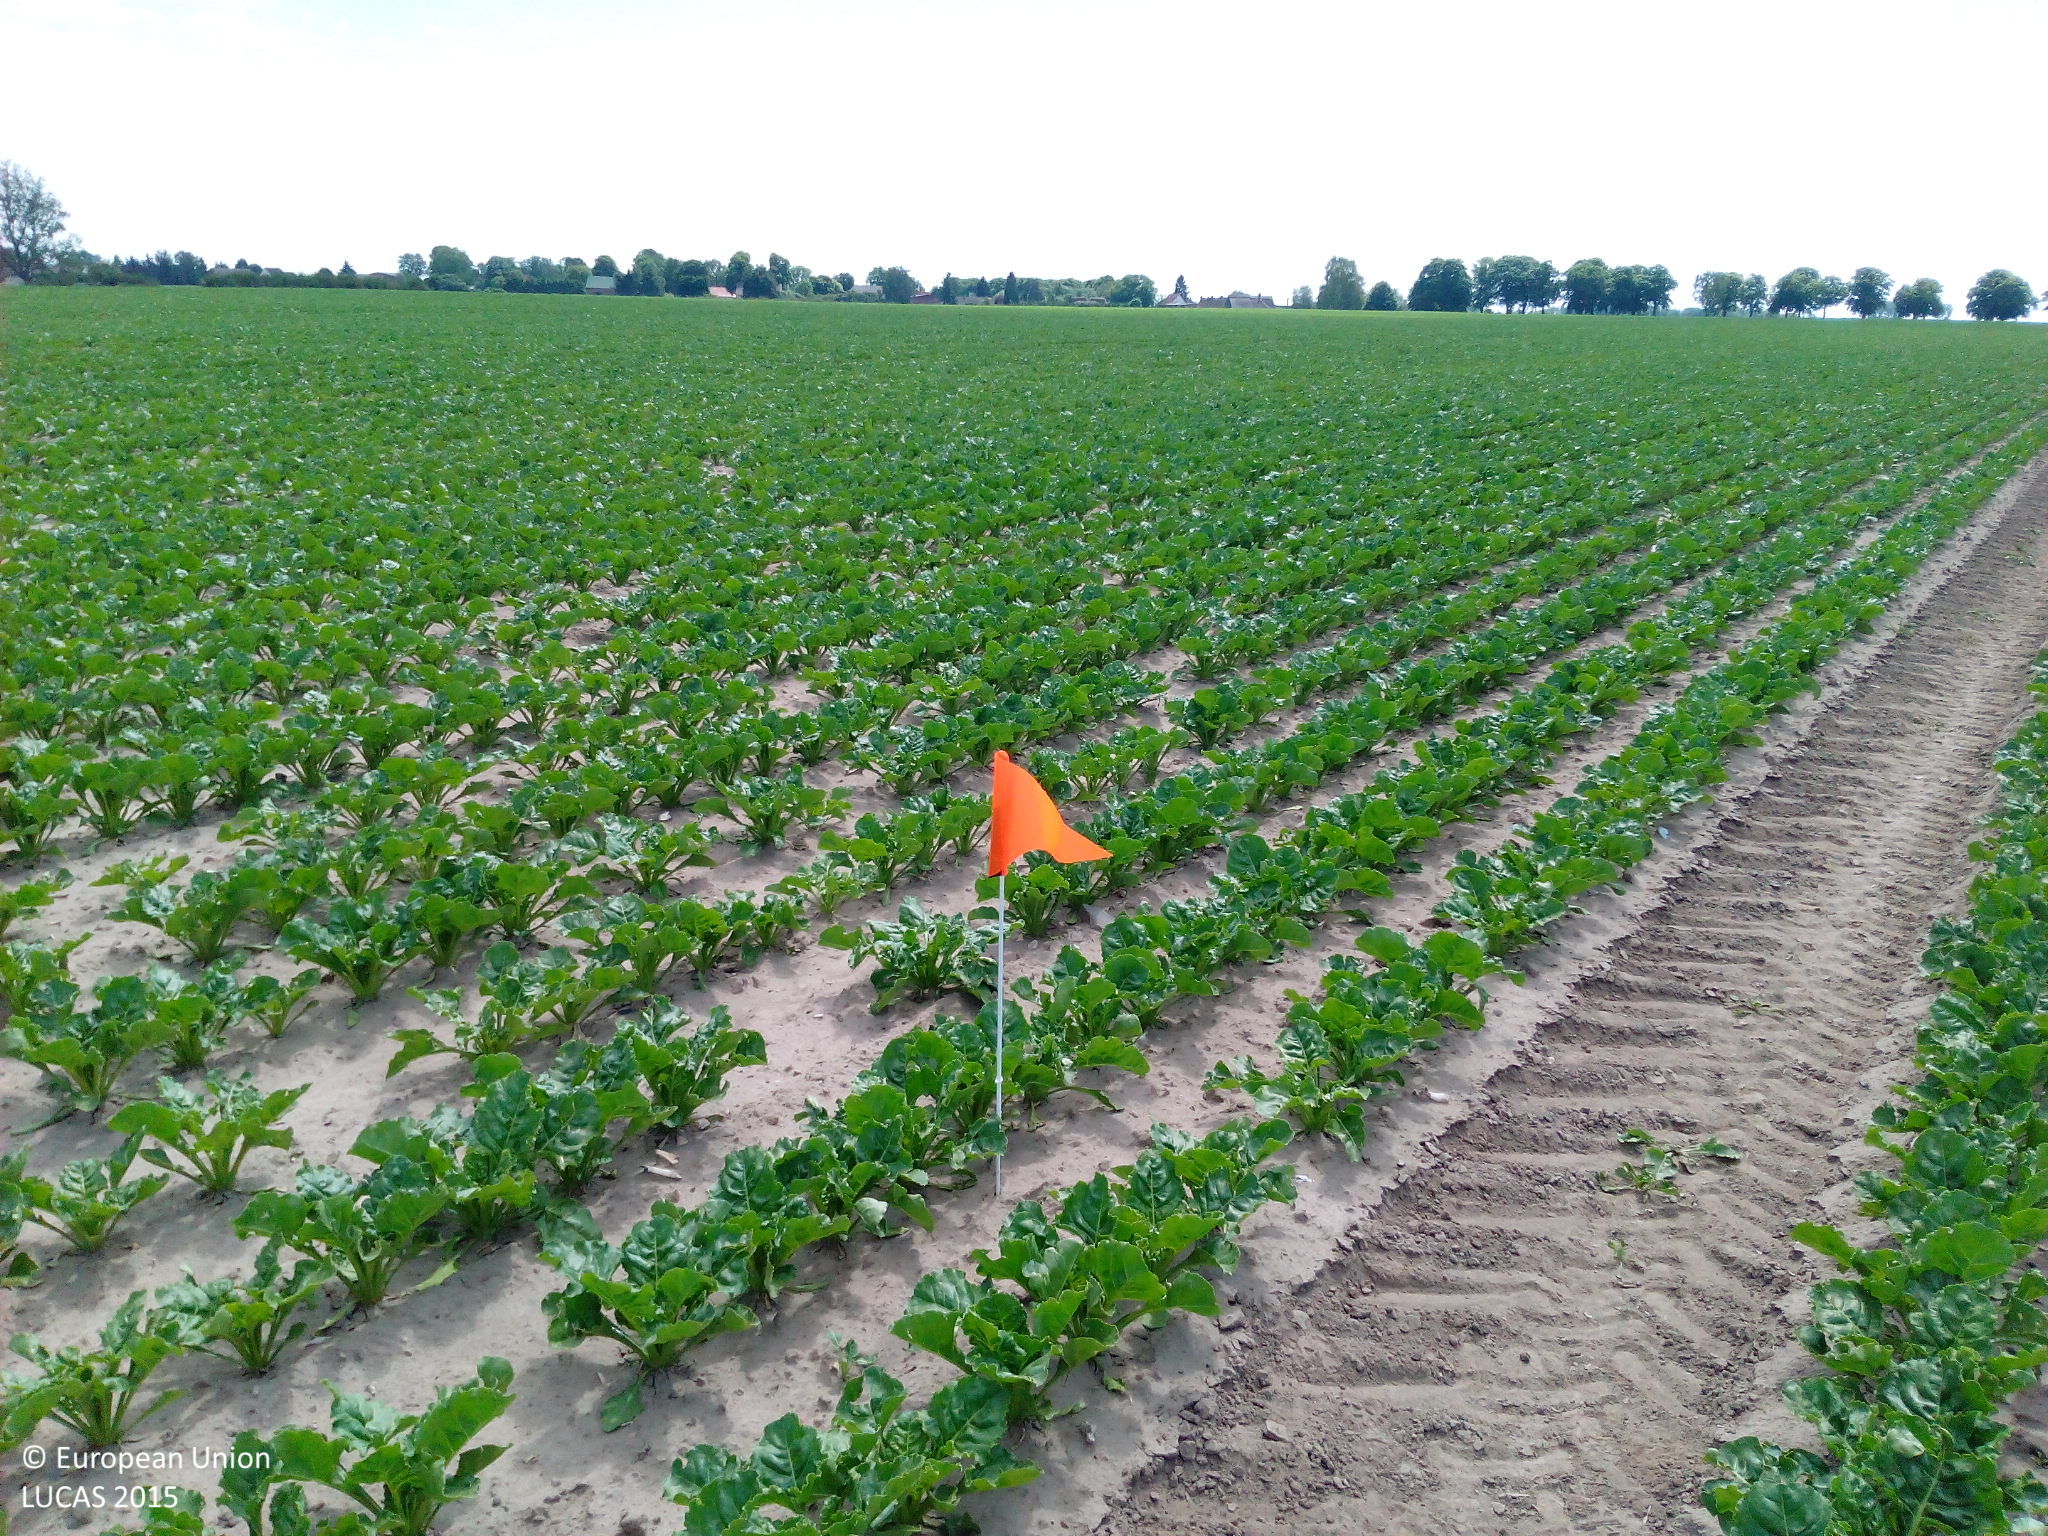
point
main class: Cropland
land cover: Sugar beet
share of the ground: 50 - 75 %
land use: Agriculture (excluding fallow land and kitchen gardens)
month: June
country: DE
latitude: 53.8476
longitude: 13.7543
